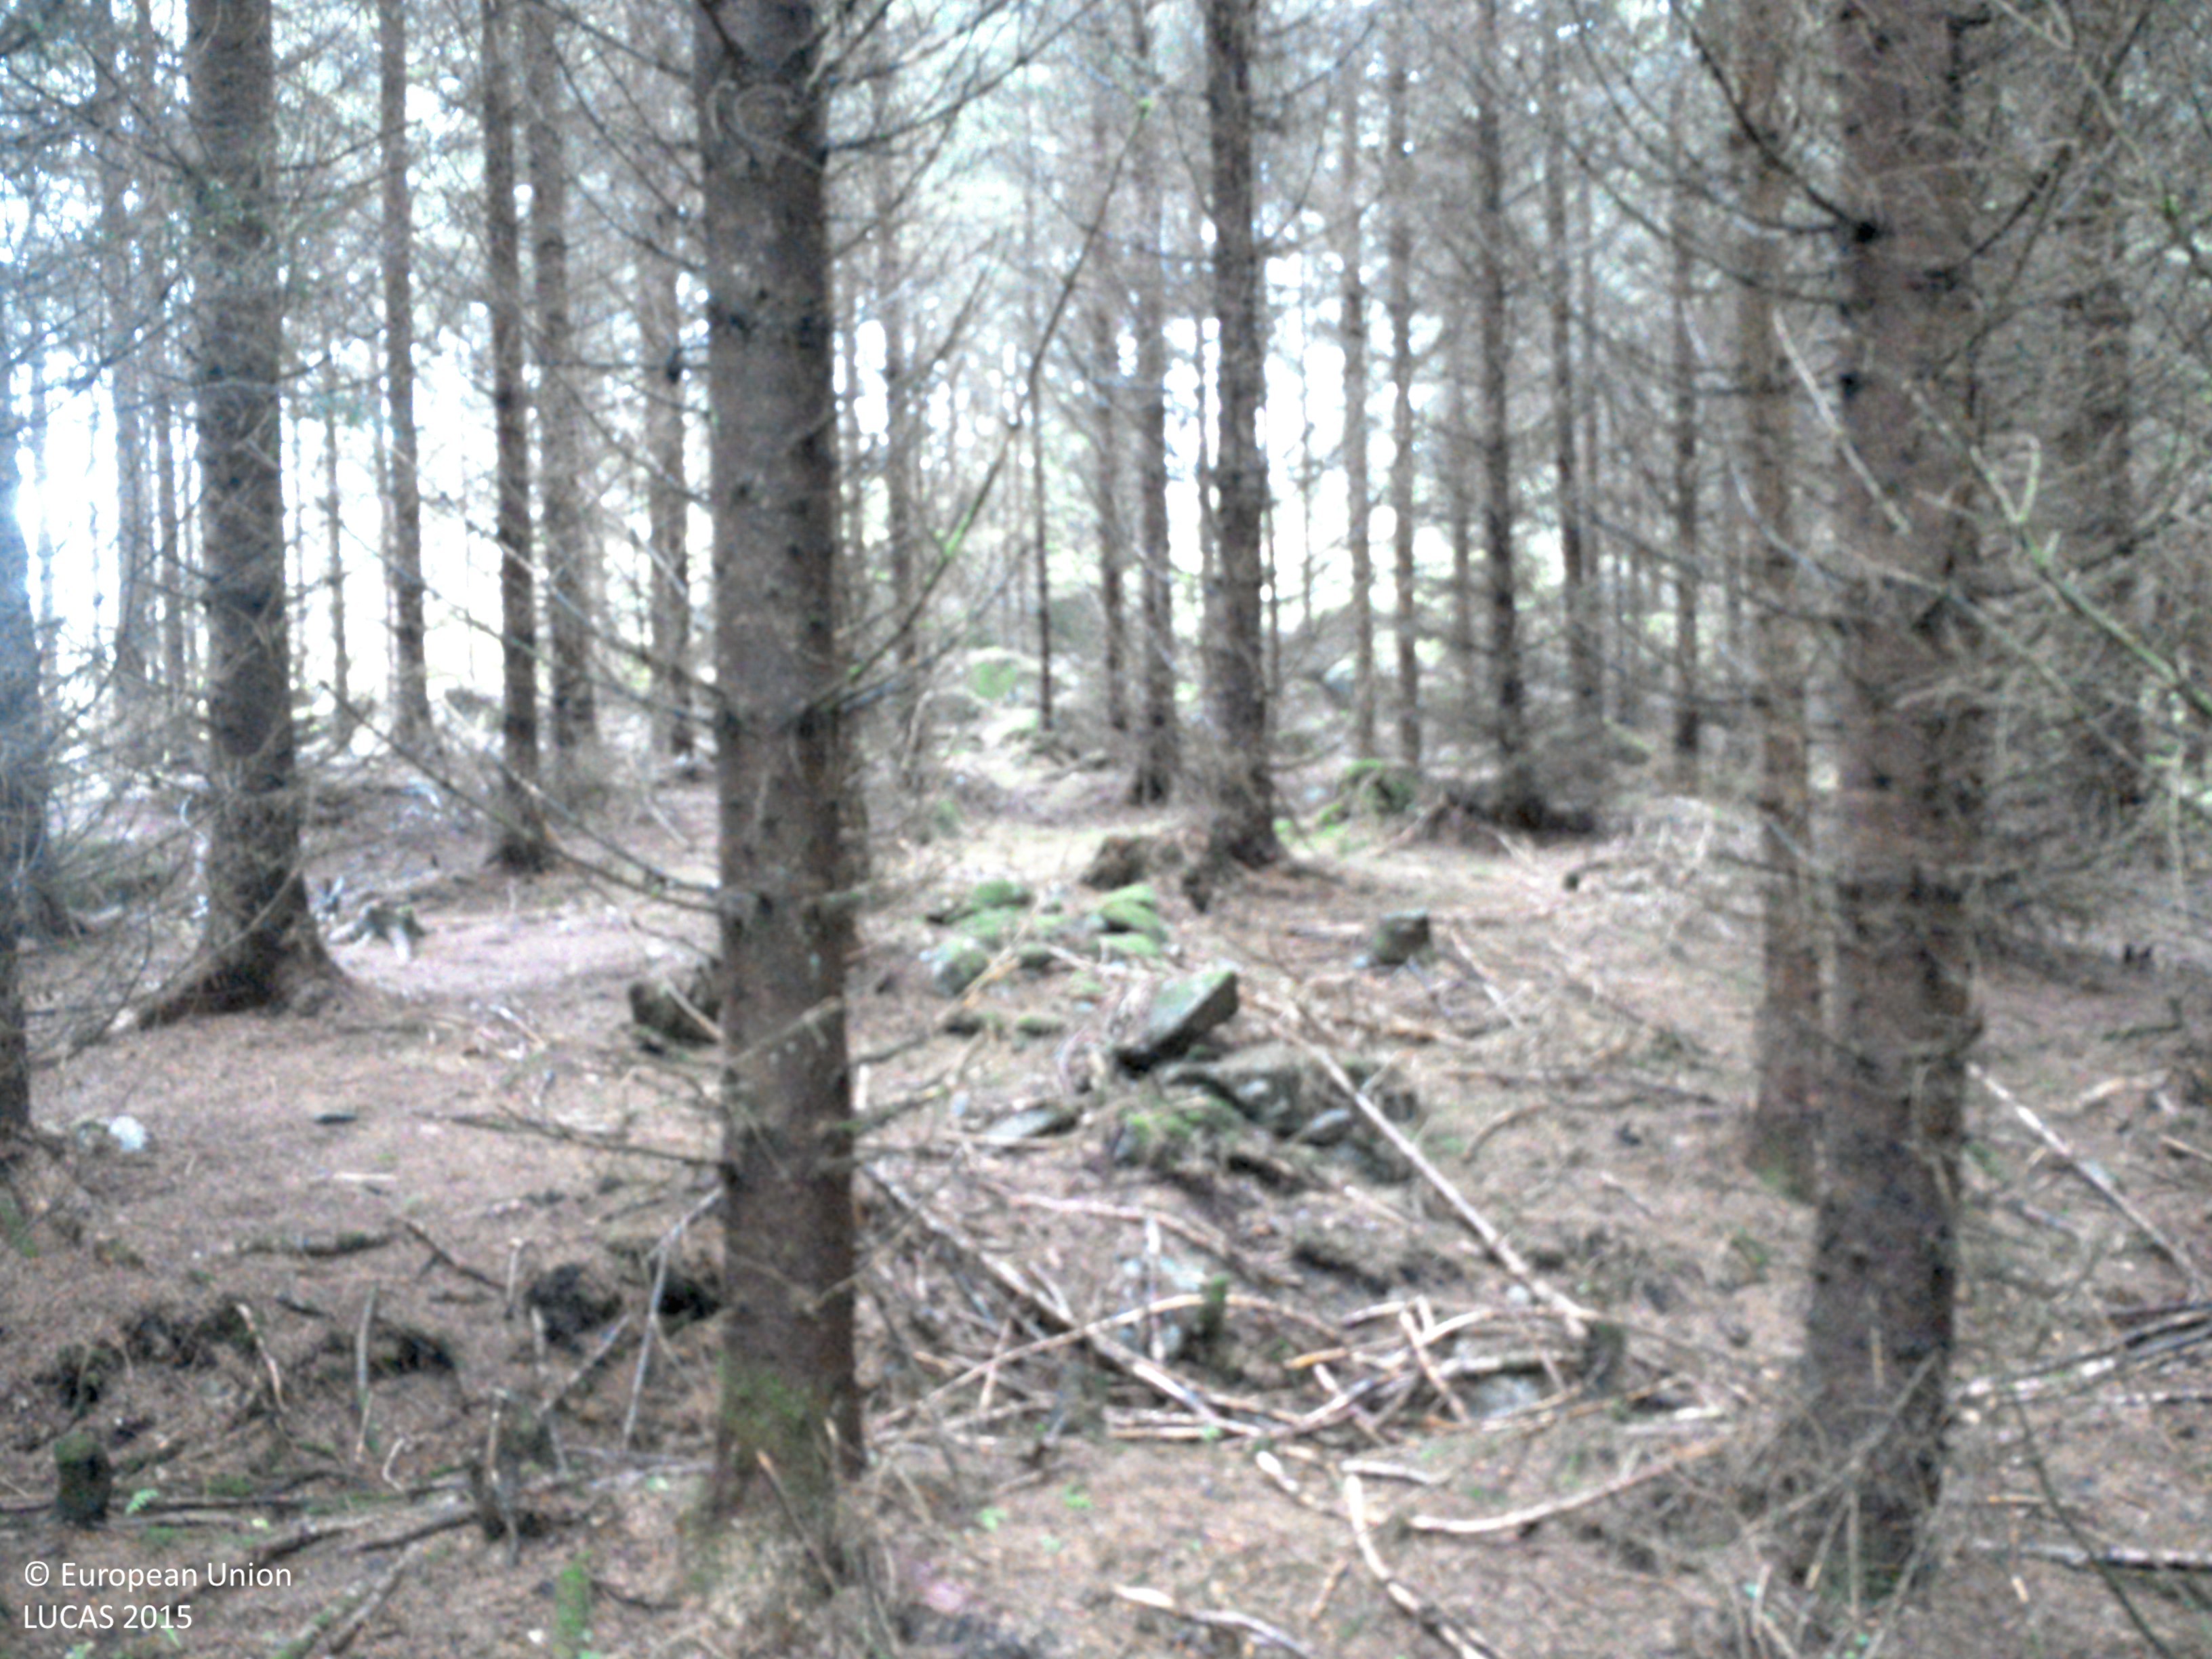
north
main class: Woodland
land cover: Spruce dominated coniferous woodland
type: boreal forest
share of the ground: > 75 %
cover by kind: coniferous forest trees 80 %, lichens and mosses 20 %
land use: Forestry
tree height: > 5 m
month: July
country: SE
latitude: 58.6902
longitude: 12.0142
